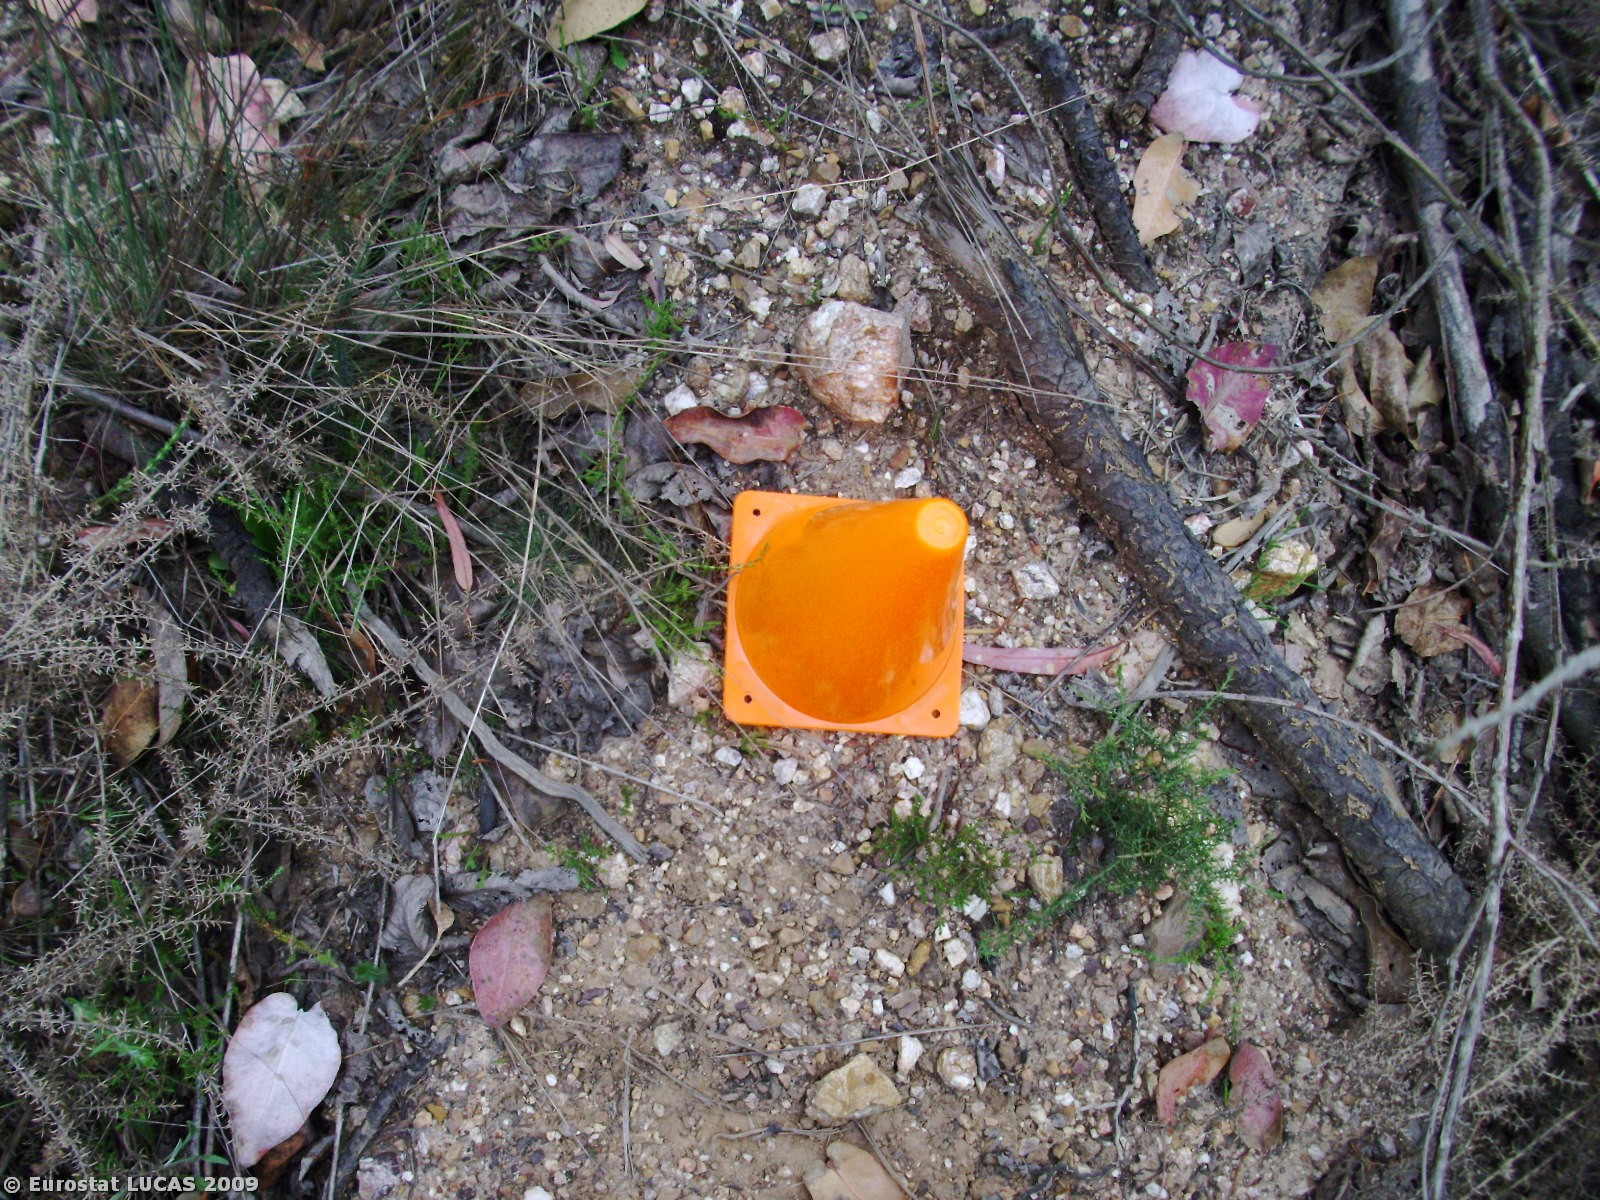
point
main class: Woodland
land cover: Broadleaved woodland
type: plantations and self-sown exotic forest
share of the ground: > 75 %
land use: Forestry
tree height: > 5 m
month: May
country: PT
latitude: 40.5134
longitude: -8.3687
